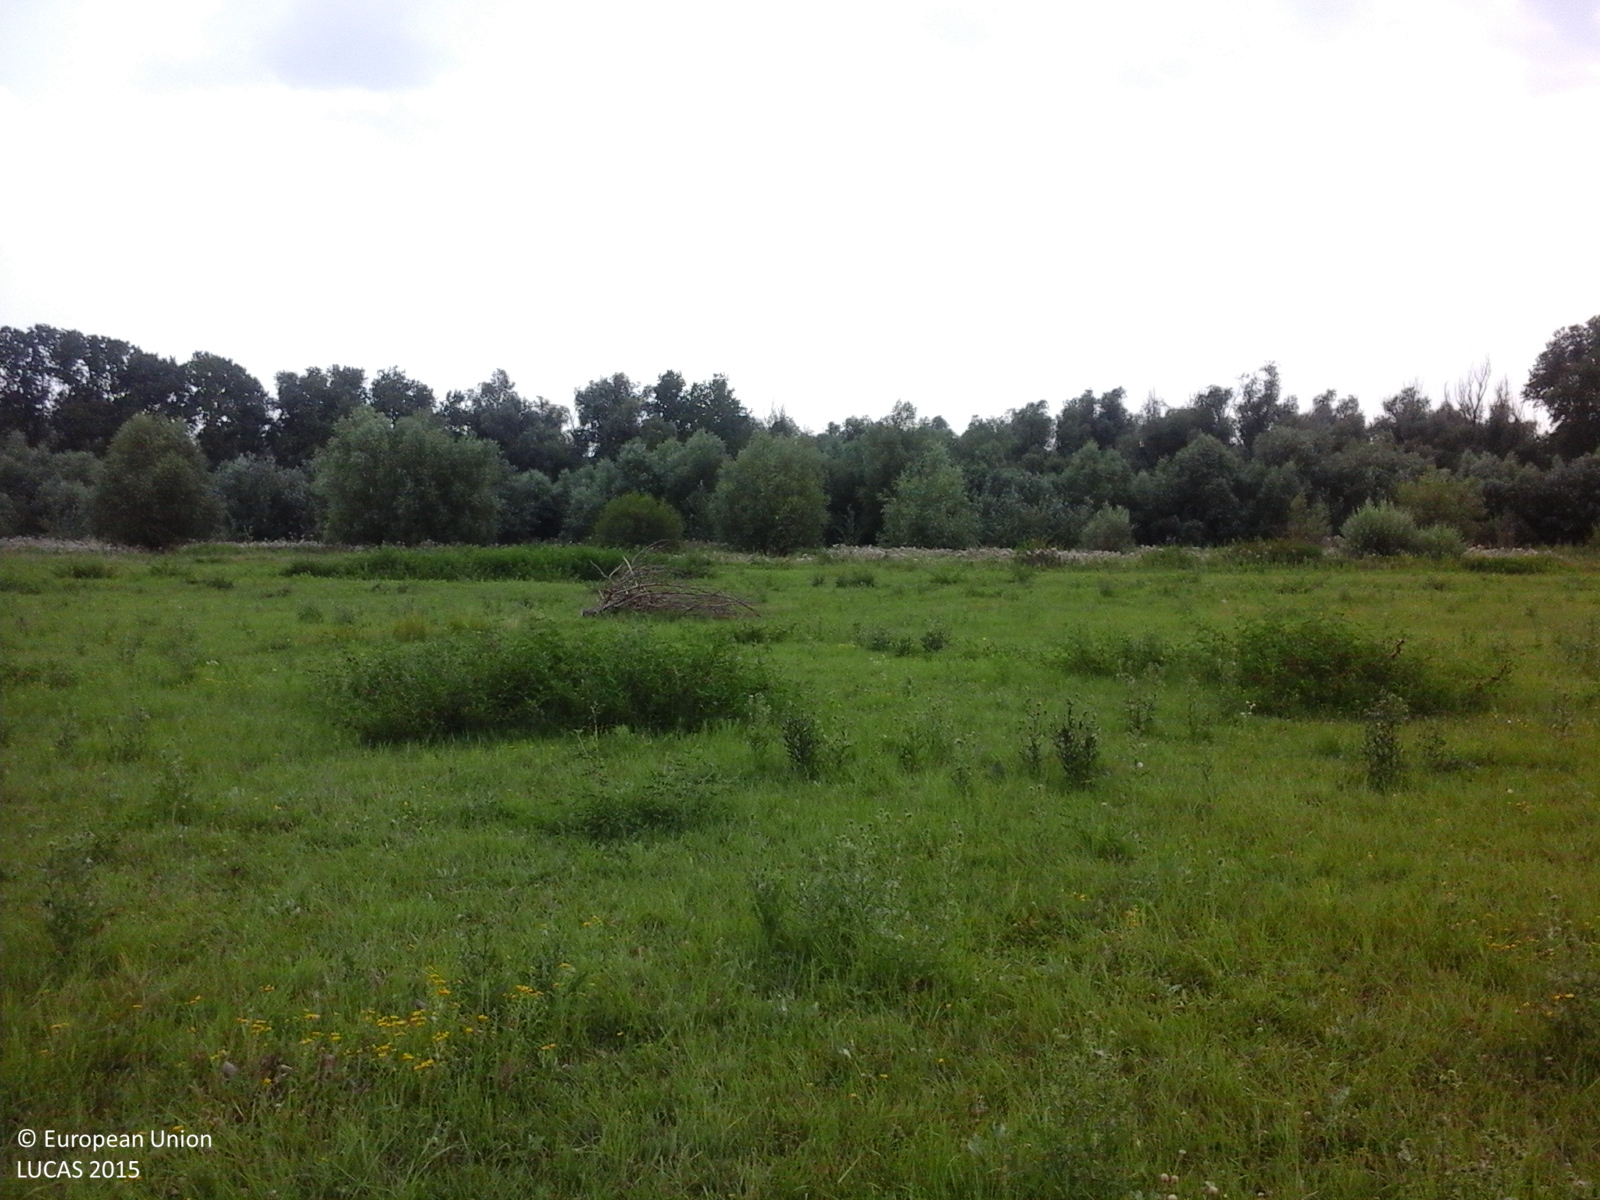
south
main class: Grassland
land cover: Spontaneously vegetated surfaces
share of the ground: > 75 %
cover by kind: herbaceous plants 100 %
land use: Agriculture (excluding fallow land and kitchen gardens)
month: July
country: RO
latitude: 46.0441
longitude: 28.1013
